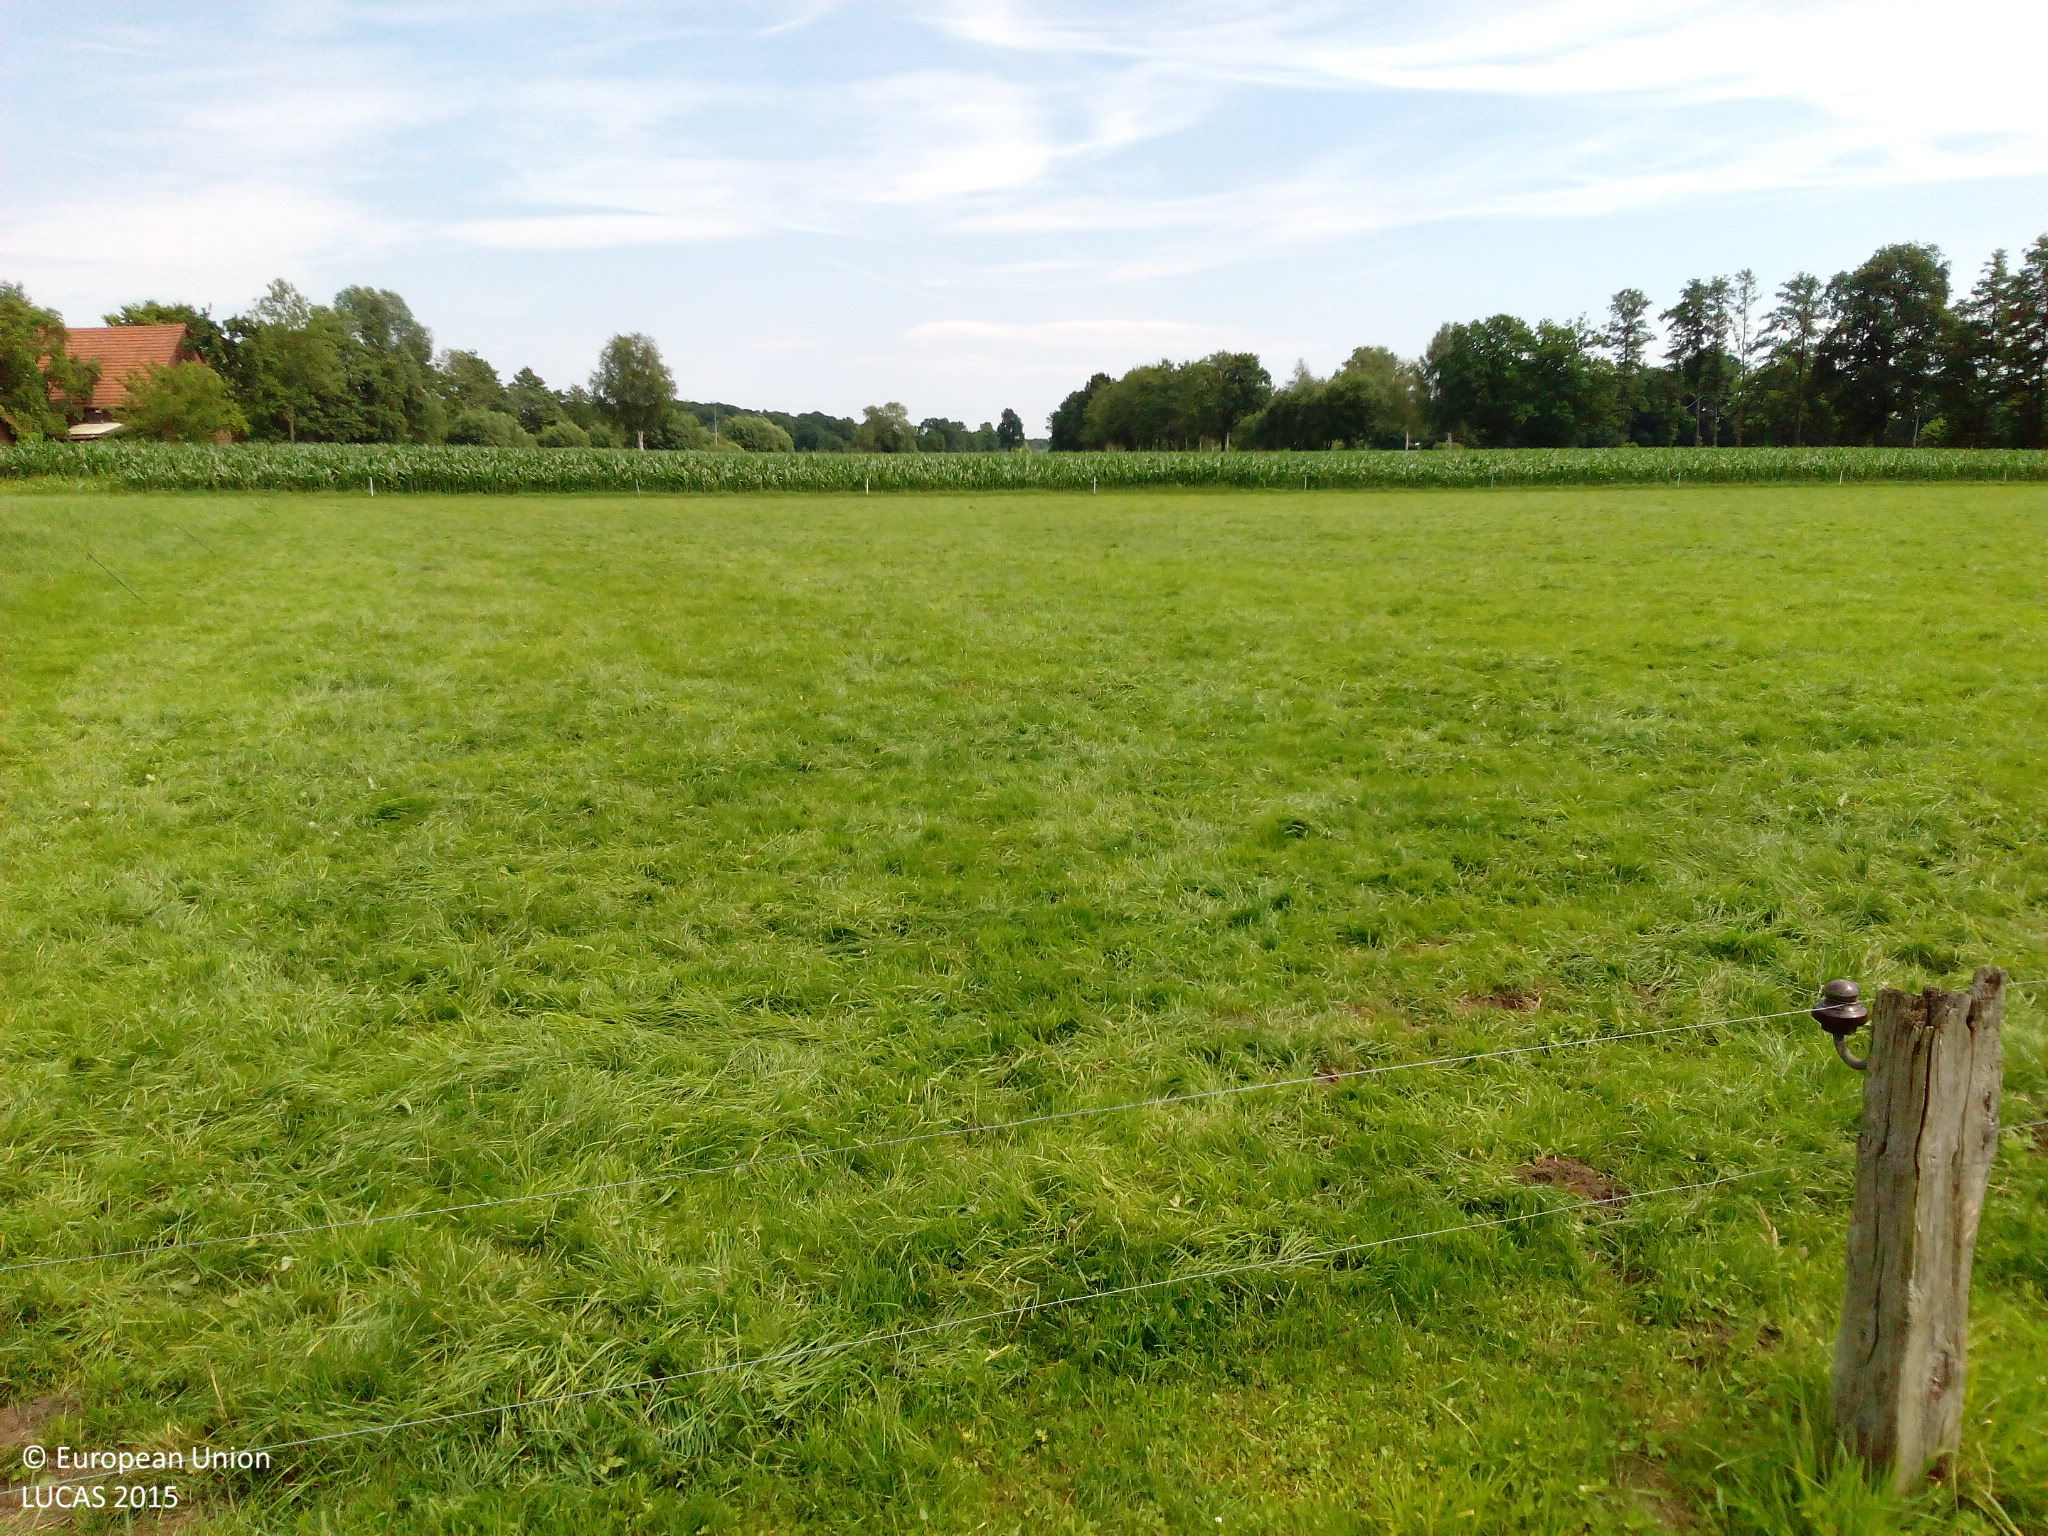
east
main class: Grassland
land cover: Grassland without tree/shrub cover
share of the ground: > 75 %
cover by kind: herbaceous plants 100 %
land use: Agriculture (excluding fallow land and kitchen gardens)
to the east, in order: Grassland without tree/shrub cover; Fences; Maize; Grass margins; Paved roads, cycling and walking lanes; Shruby margins; Ditches and canals; Barley; Electric lines; Barley
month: July
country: DE
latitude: 51.8643
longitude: 8.4756
